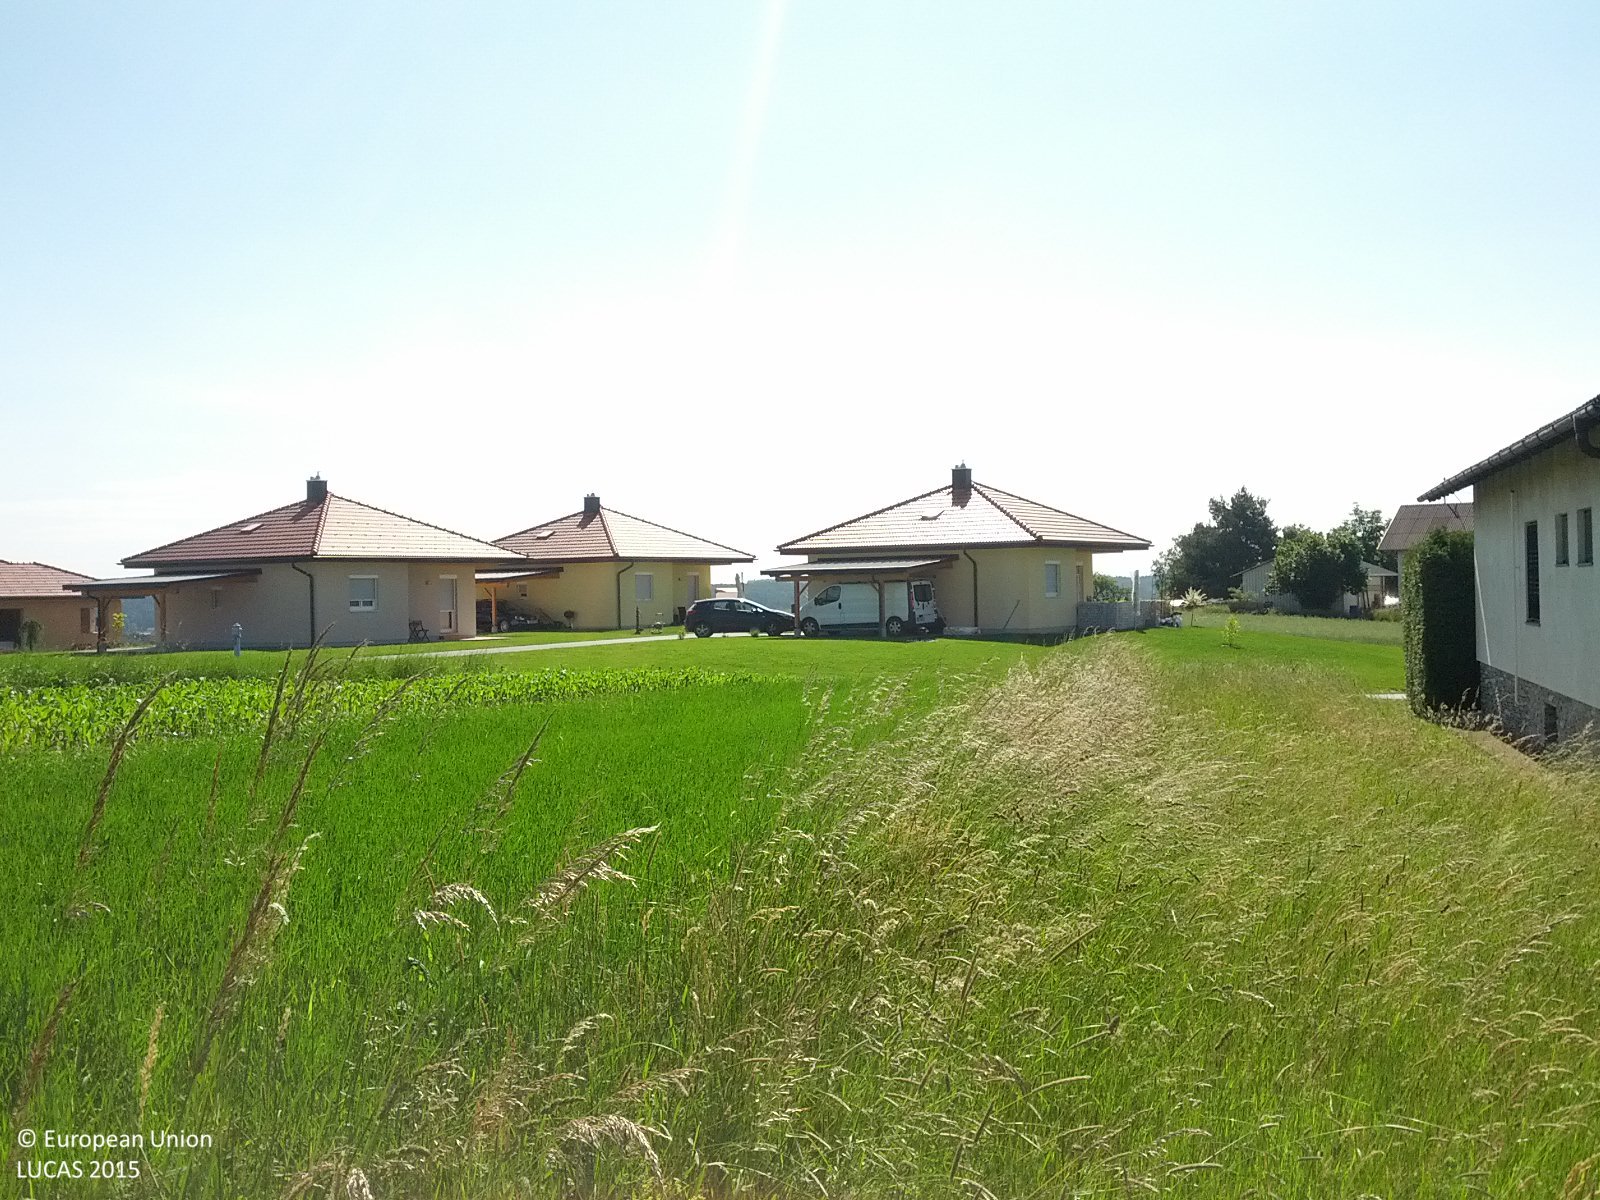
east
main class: Grassland
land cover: Grassland without tree/shrub cover
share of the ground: > 75 %
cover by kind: herbaceous plants 100 %
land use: Agriculture (excluding fallow land and kitchen gardens)
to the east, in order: Grassland without tree/shrub cover; Barley; Maize; Grassland without tree/shrub cover; Paved roads, cycling and walking lanes; Grassland without tree/shrub cover; Artificial constructions in urban areas; Grass margins; Rye; Temporary grasslands; Other bare soil; Grassland without tree/shrub cover; Paved roads, cycling and walking lanes; Grass margins; Other fibre and oleaginous crops
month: June
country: AT
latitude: 47.1861
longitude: 16.1384
